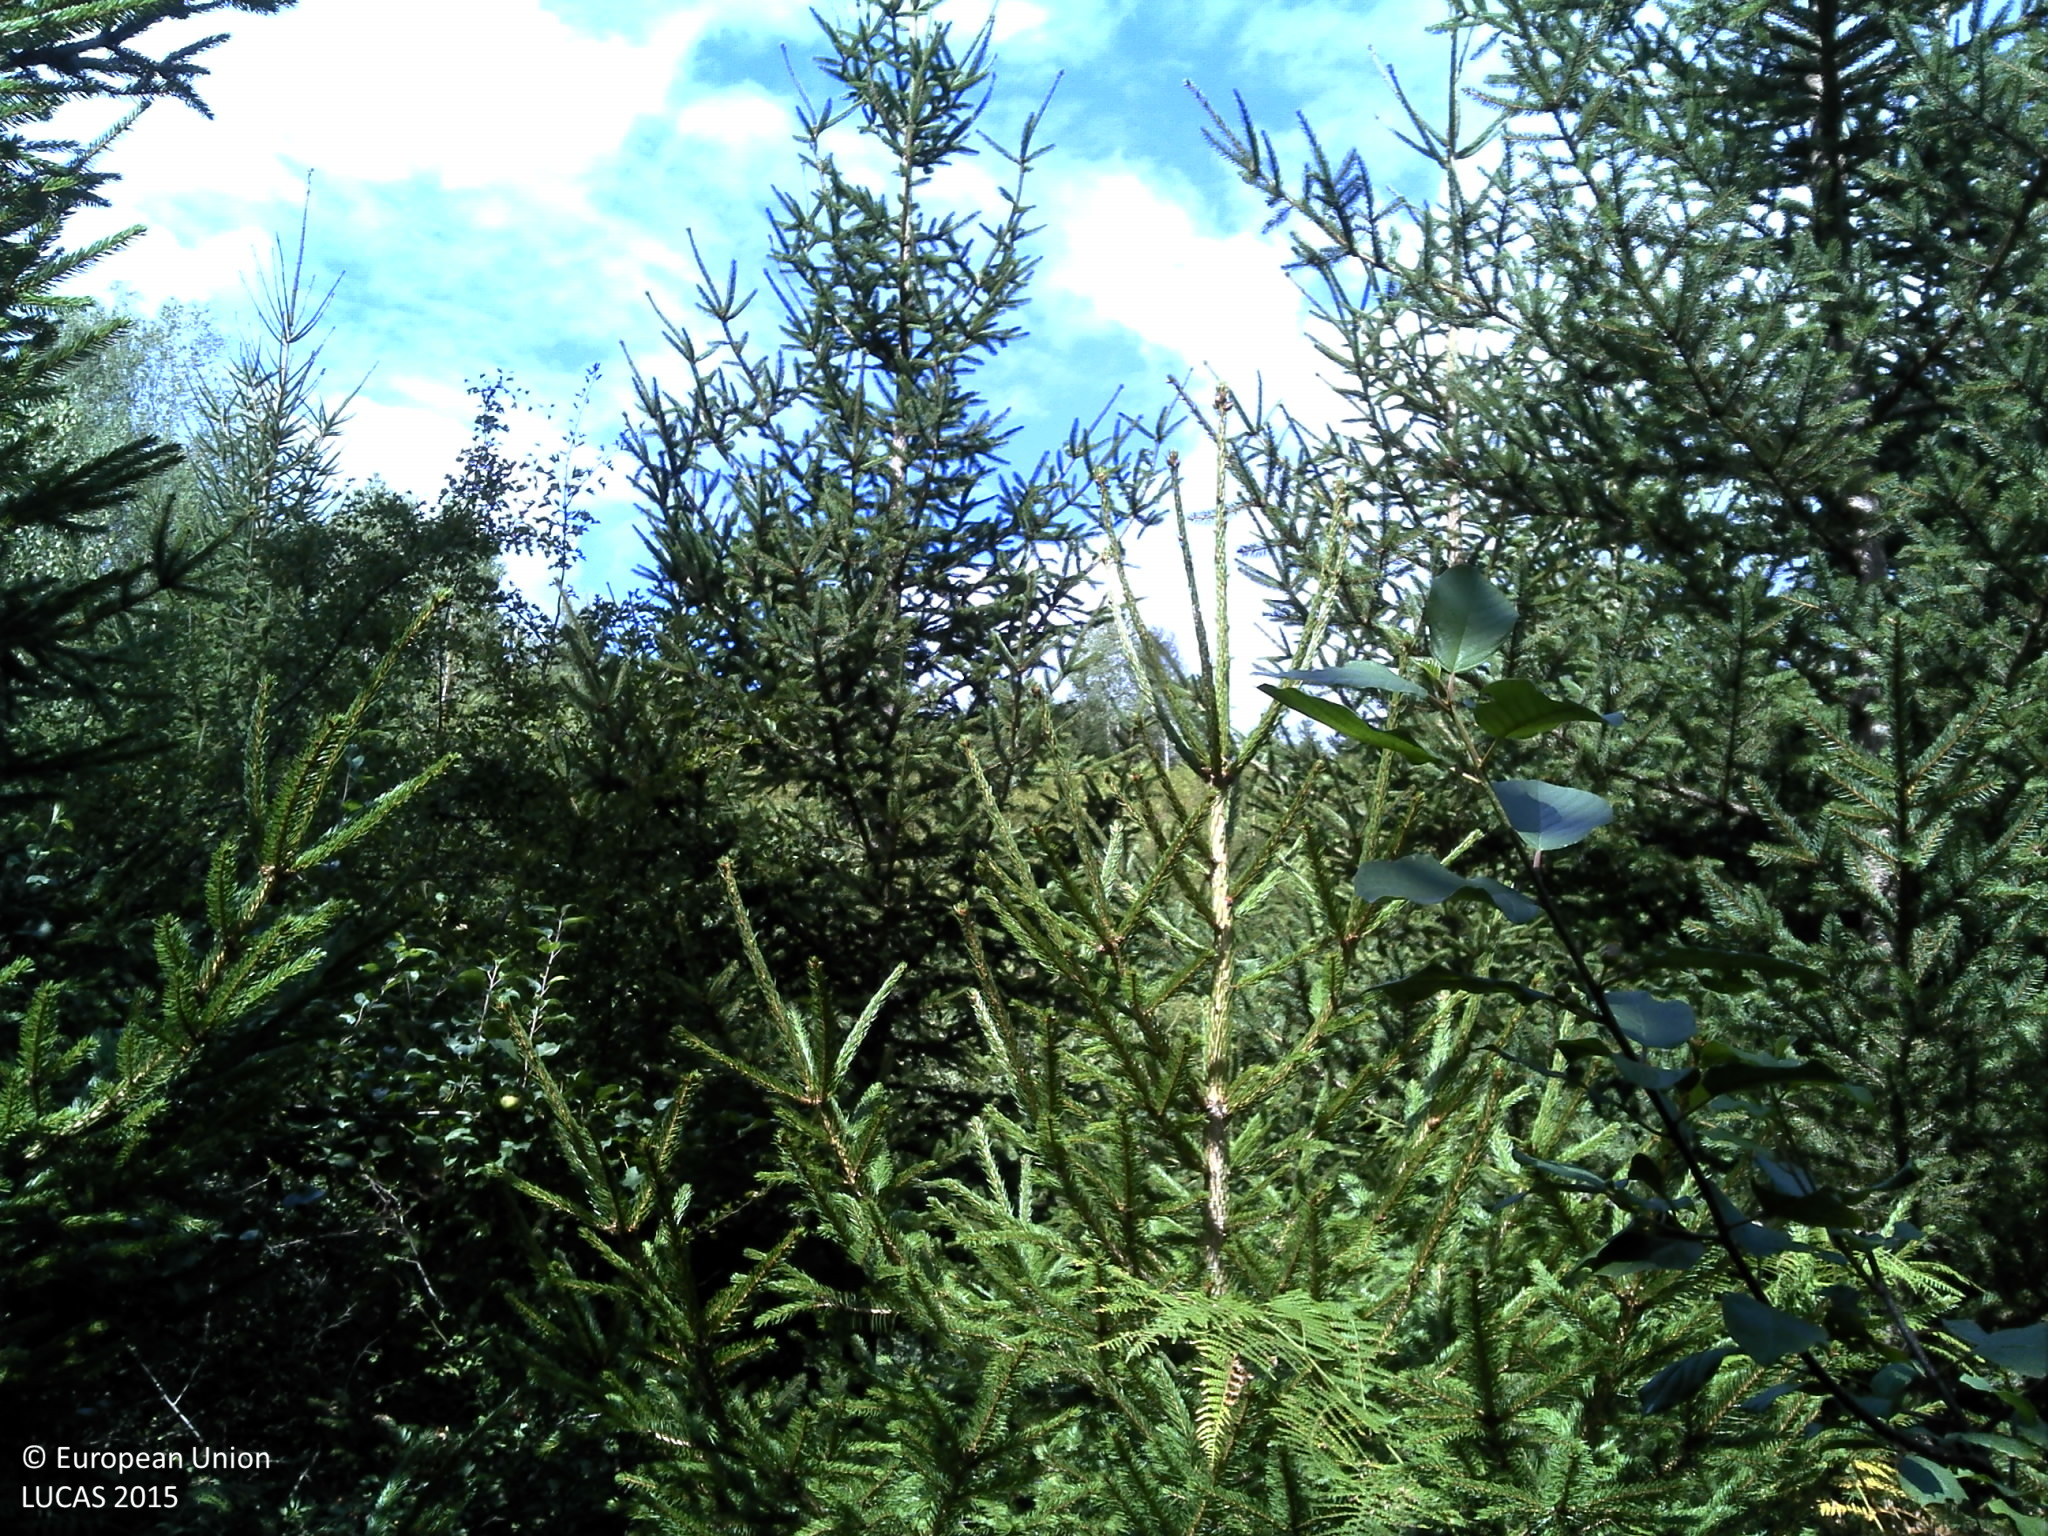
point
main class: Woodland
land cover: Spruce dominated coniferous woodland
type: coniferous forest of the mediterranean region
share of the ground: > 75 %
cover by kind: coniferous forest trees 100 %
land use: Forestry
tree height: > 5 m
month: September
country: HR
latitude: 45.2984
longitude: 15.3131
